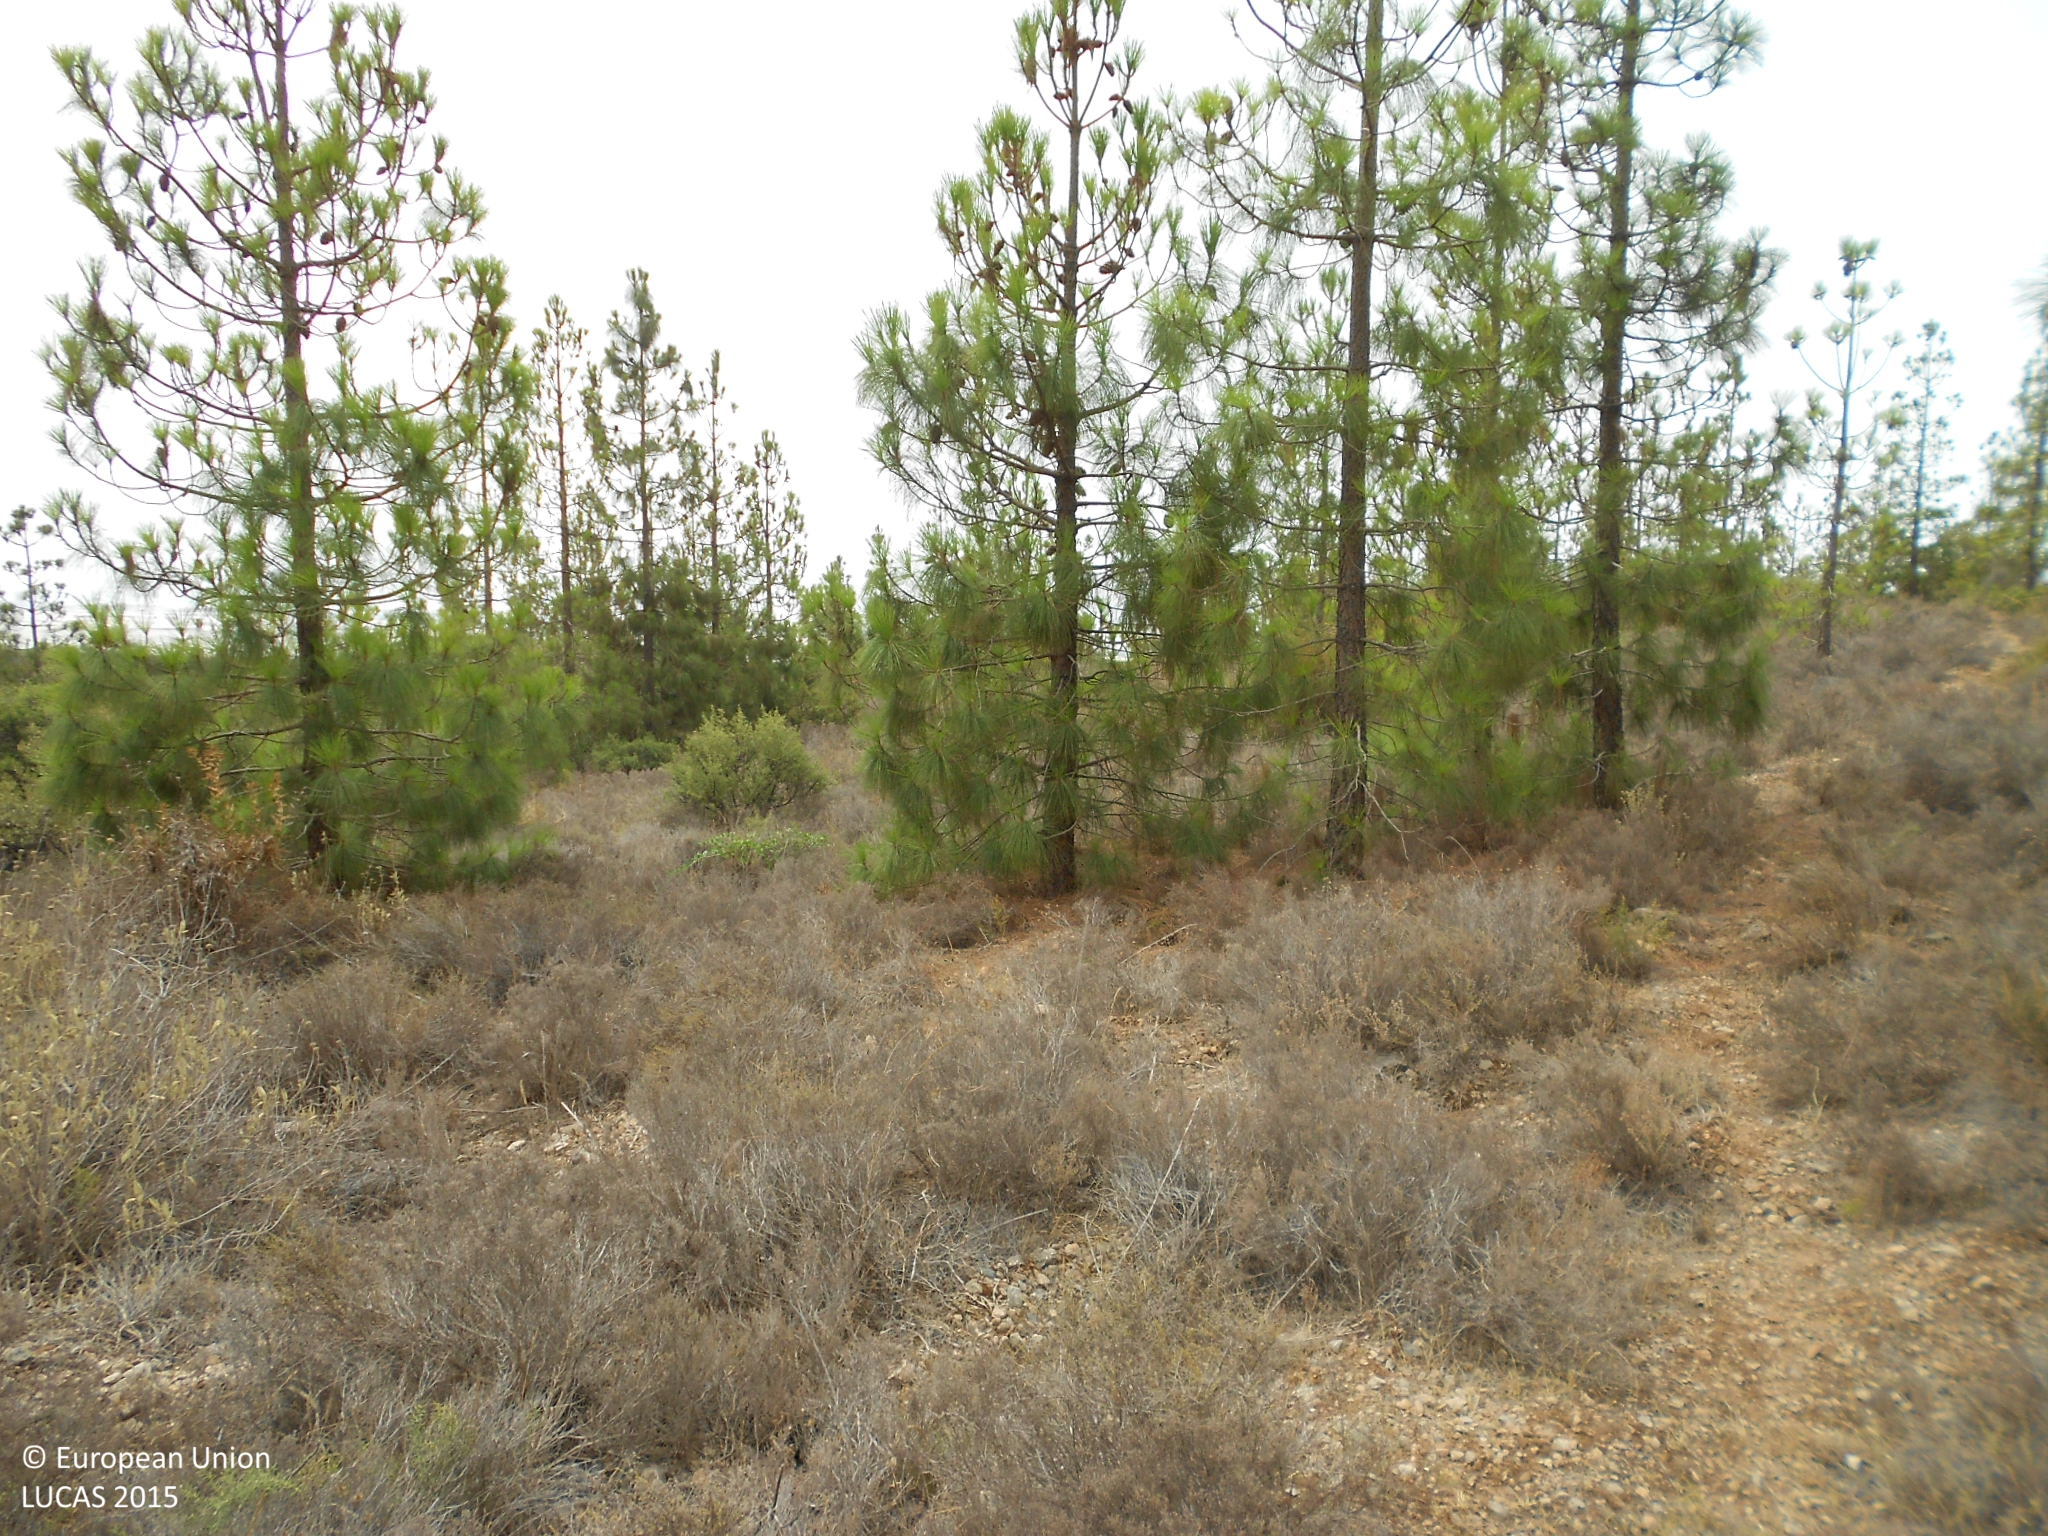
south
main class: Woodland
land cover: Pine dominated coniferous woodland
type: coniferous forest of the mediterranean region
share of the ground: 10 - 25 %
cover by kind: shrubs 40 %, herbaceous plants 40 %, coniferous forest trees 15 %, consolidated bare surface 5 %
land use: Forestry
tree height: > 5 m
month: August
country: ES
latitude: 36.8159
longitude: -2.7223
